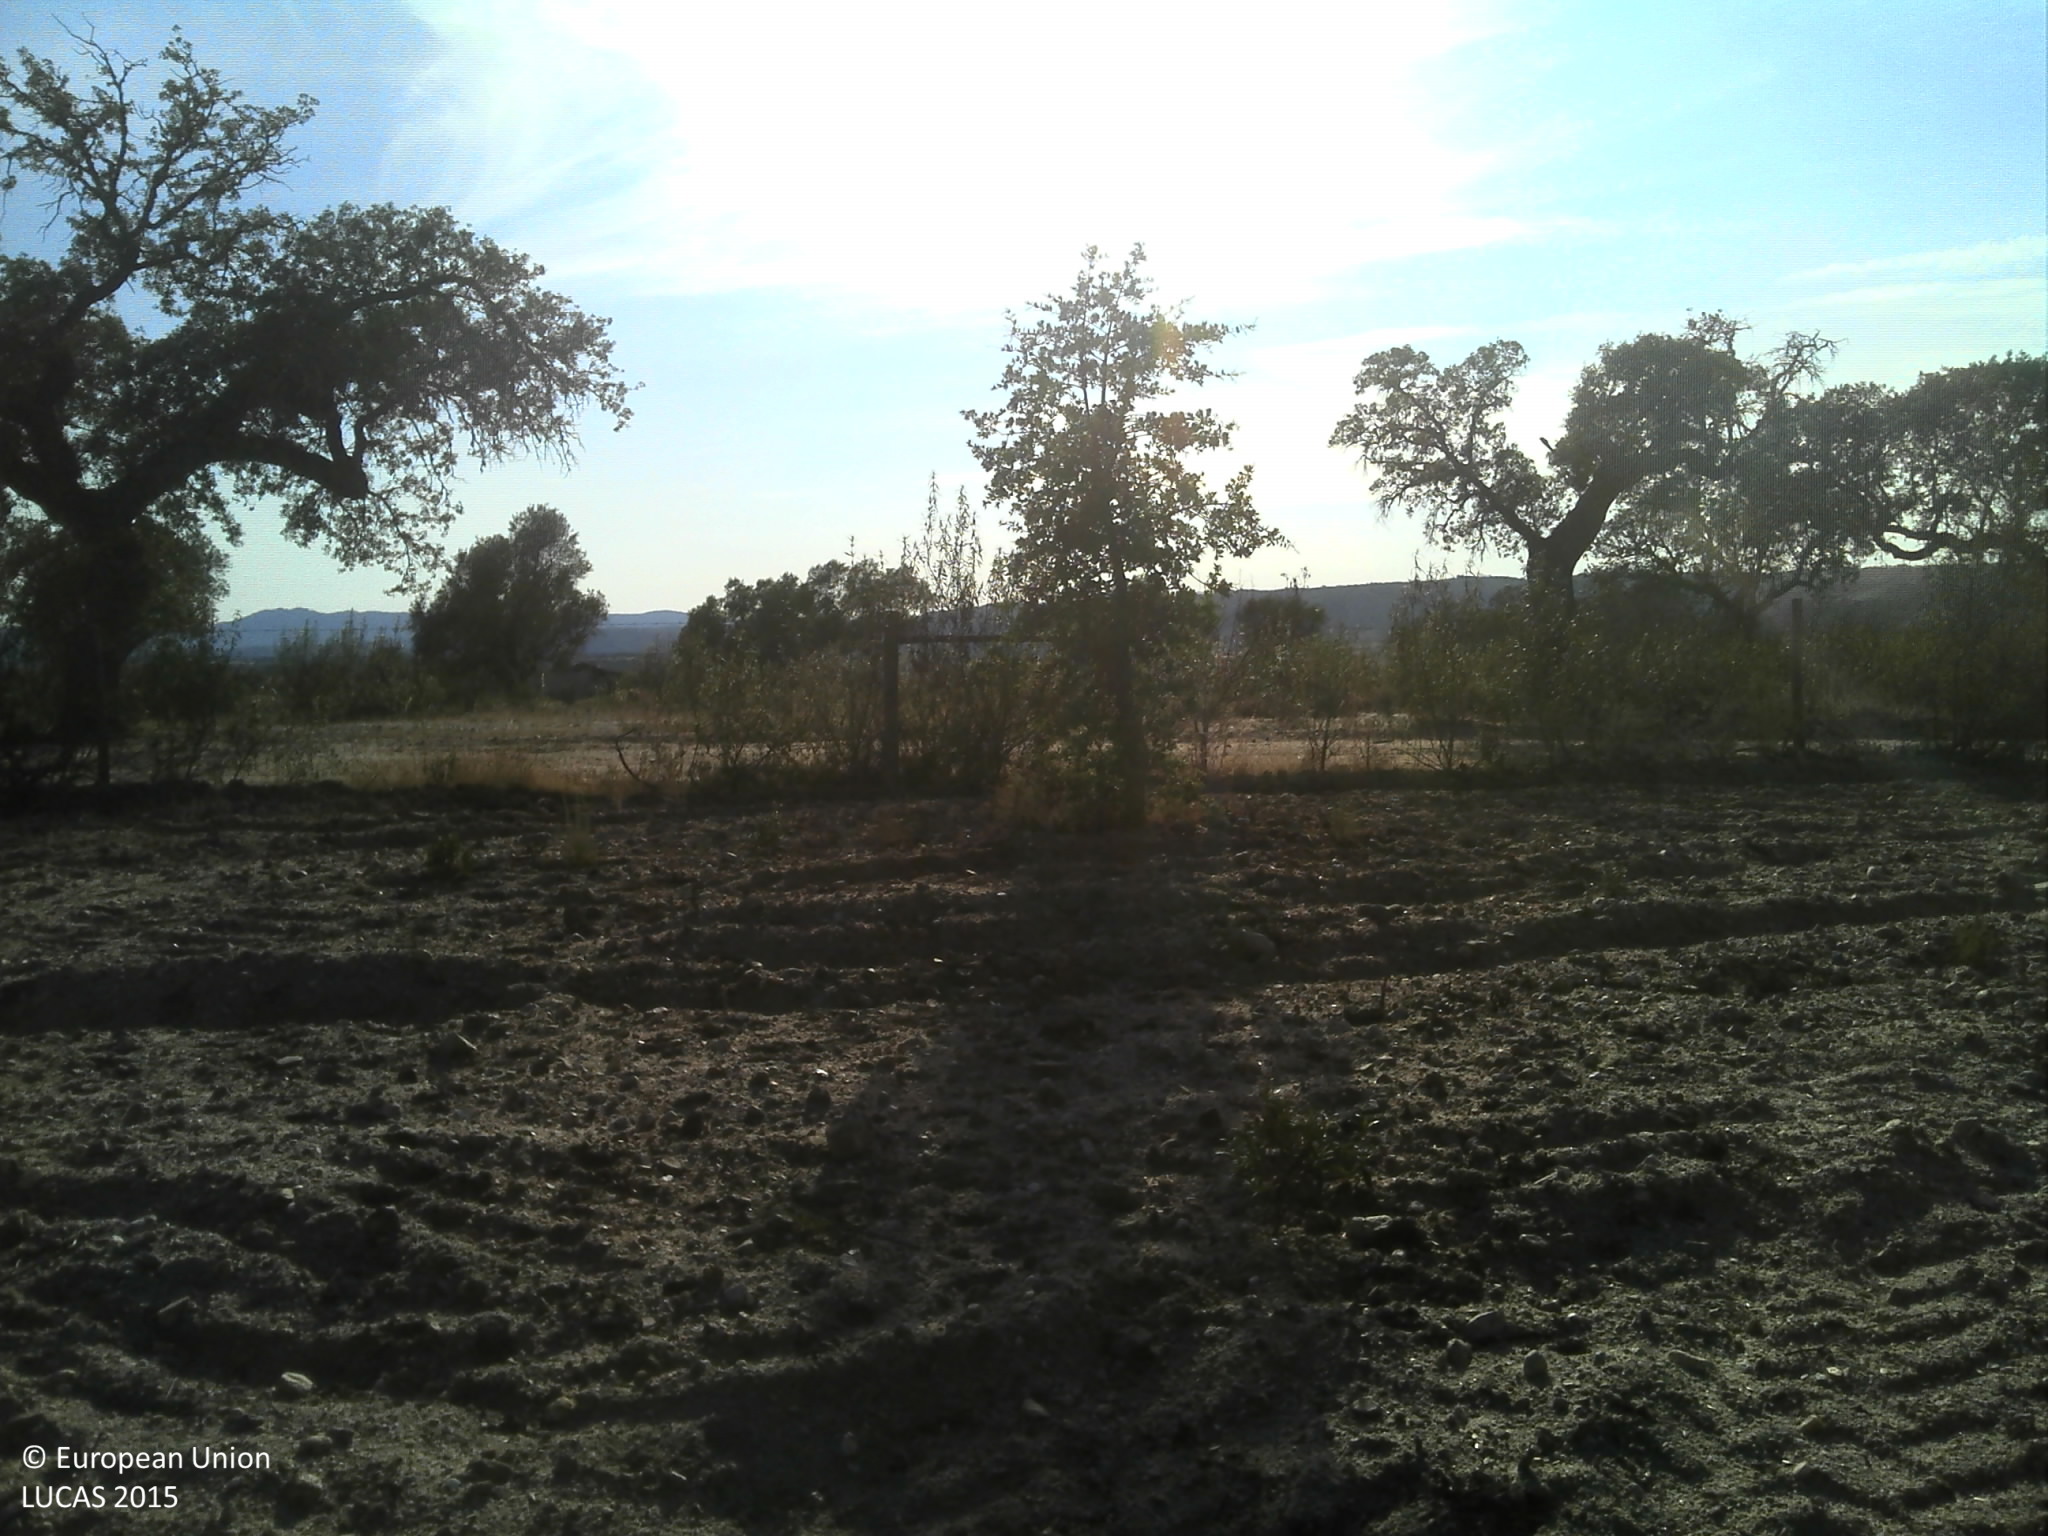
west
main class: Woodland
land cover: Broadleaved woodland
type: broadleaved evergreen forest
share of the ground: 10 - 25 %
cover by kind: unconsolidated bare surface 65 %, broadleaved forest trees 25 %, shrubs 5 %, herbaceous plants 5 %
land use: Forestry
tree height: < 5 m
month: July
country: PT
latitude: 39.7121
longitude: -7.5125
